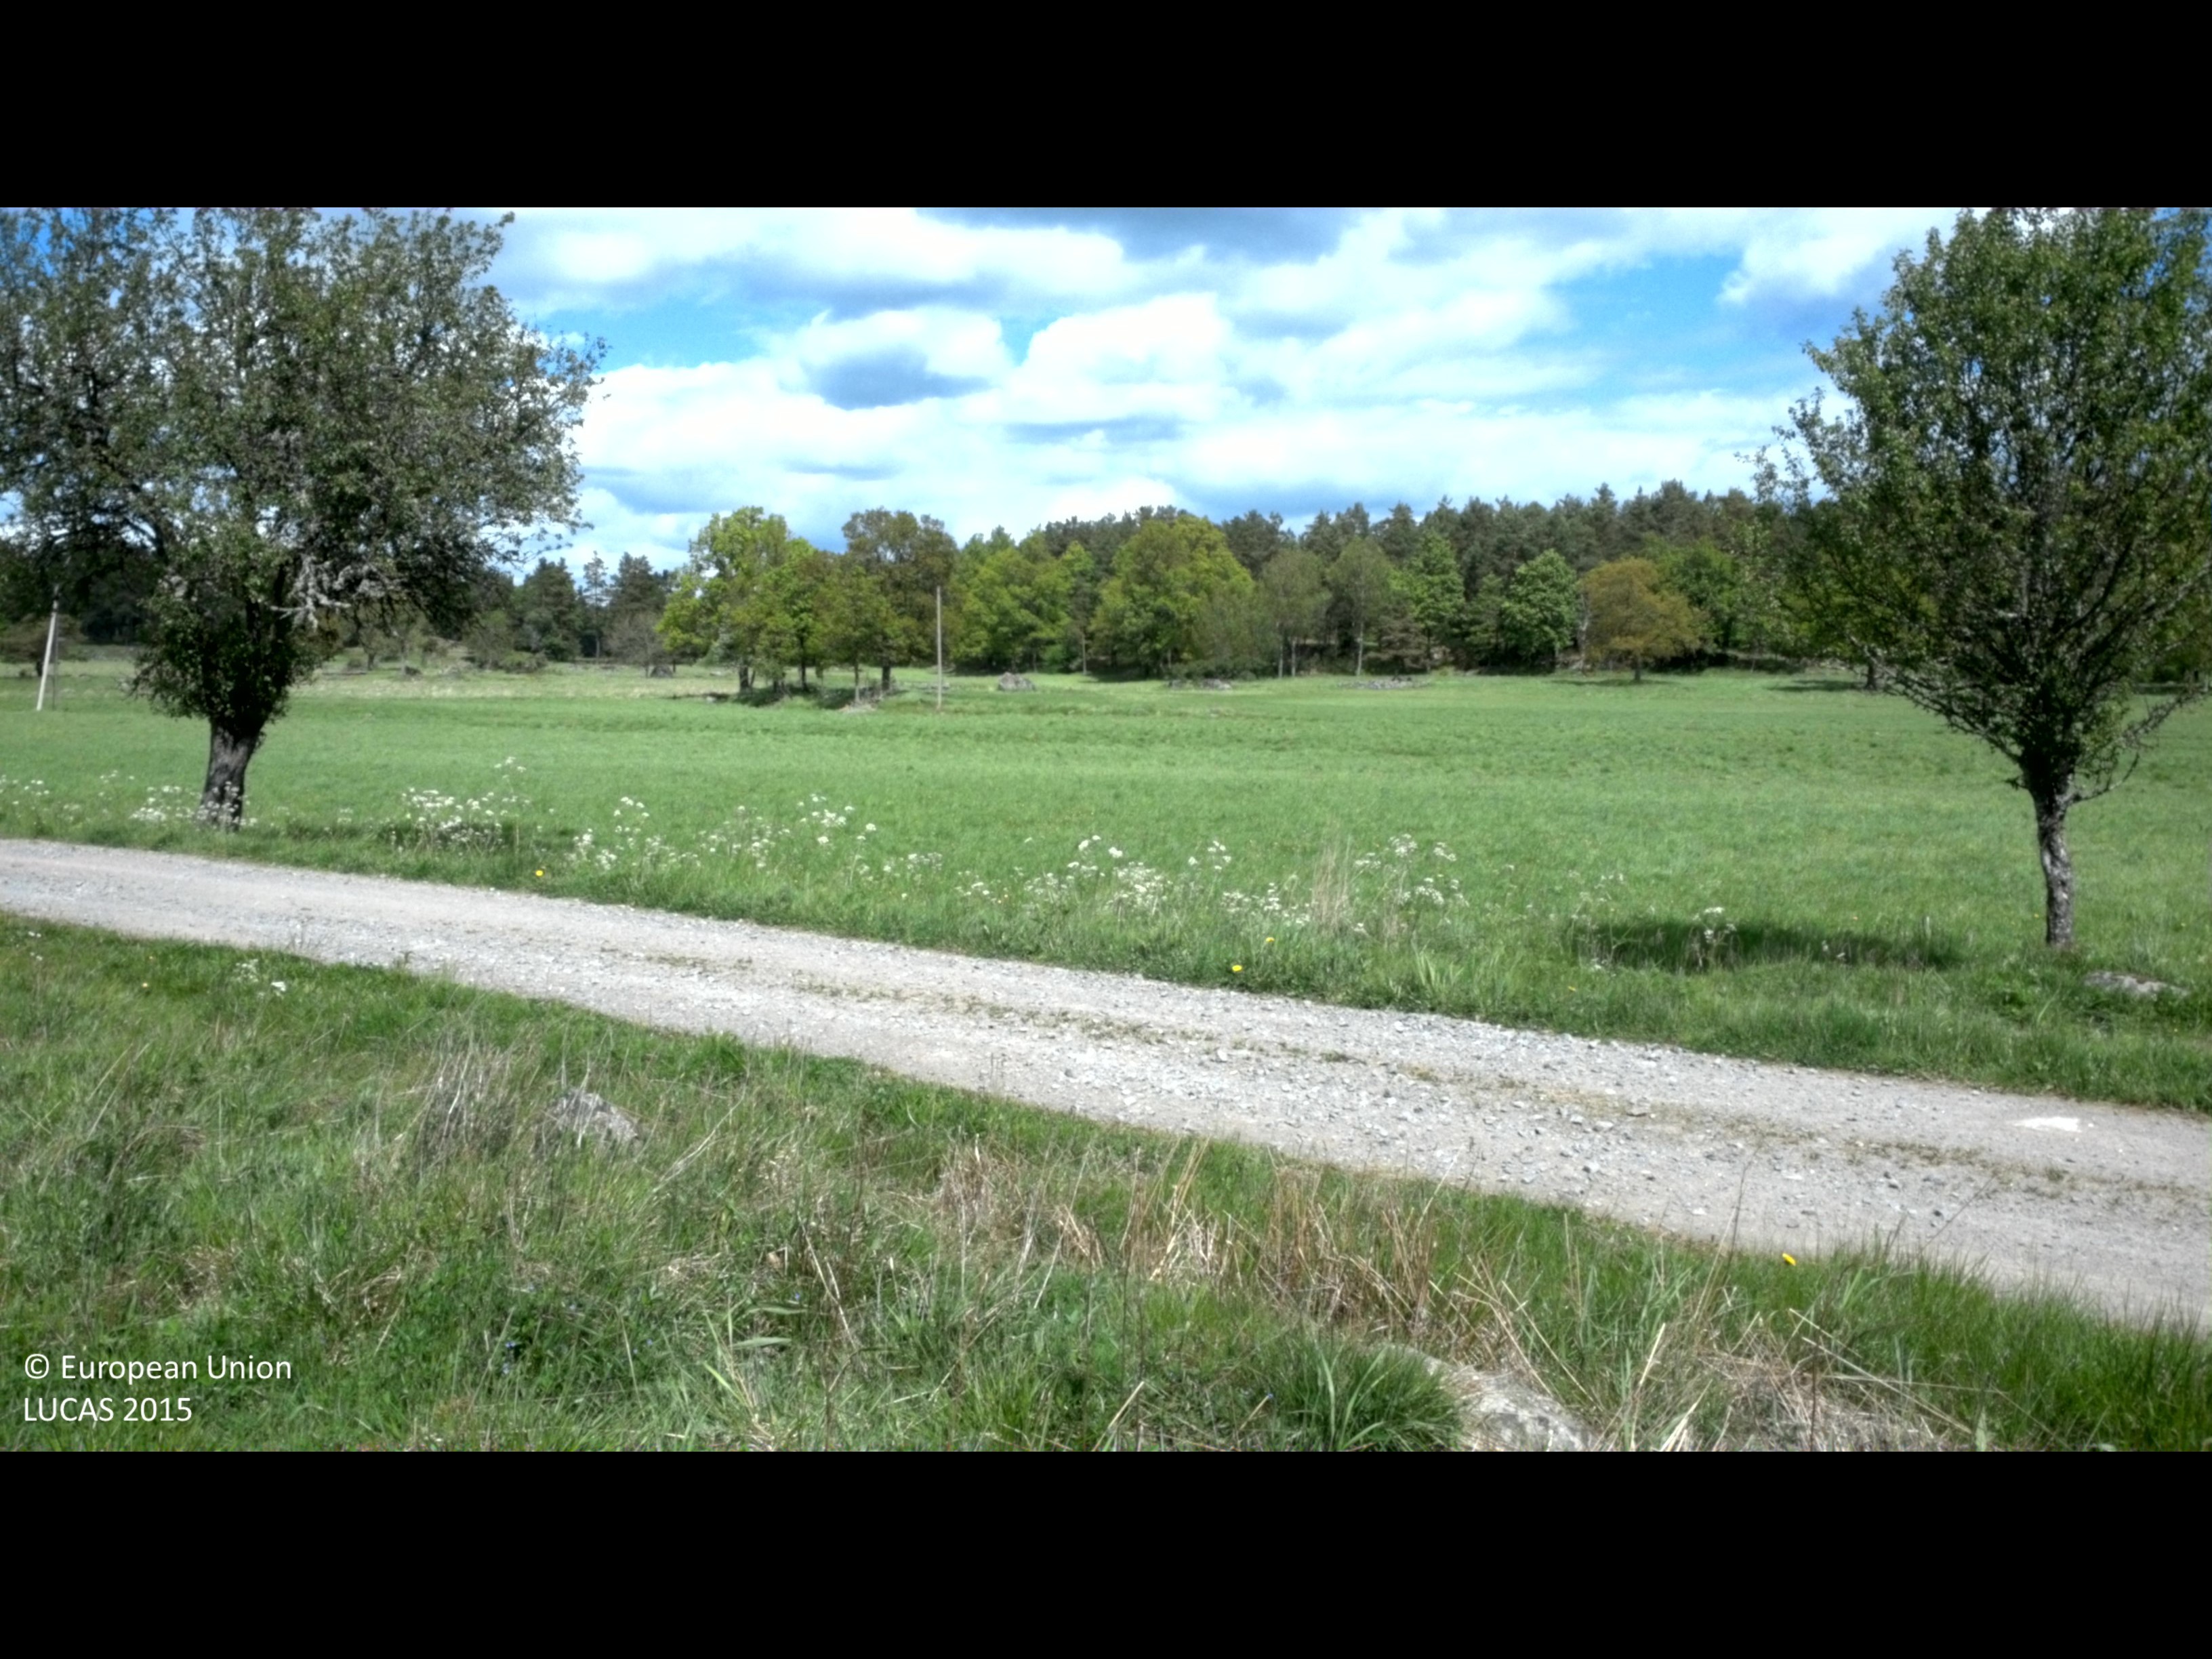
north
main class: Grassland
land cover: Grassland with sparse tree/shrub cover
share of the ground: > 75 %
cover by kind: herbaceous plants 75 %, shrubs 10 %, unconsolidated bare surface 10 %, broadleaved forest trees 5 %
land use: Agriculture (excluding fallow land and kitchen gardens)
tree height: > 5 m
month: May
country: SE
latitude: 57.5177
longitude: 16.5606
